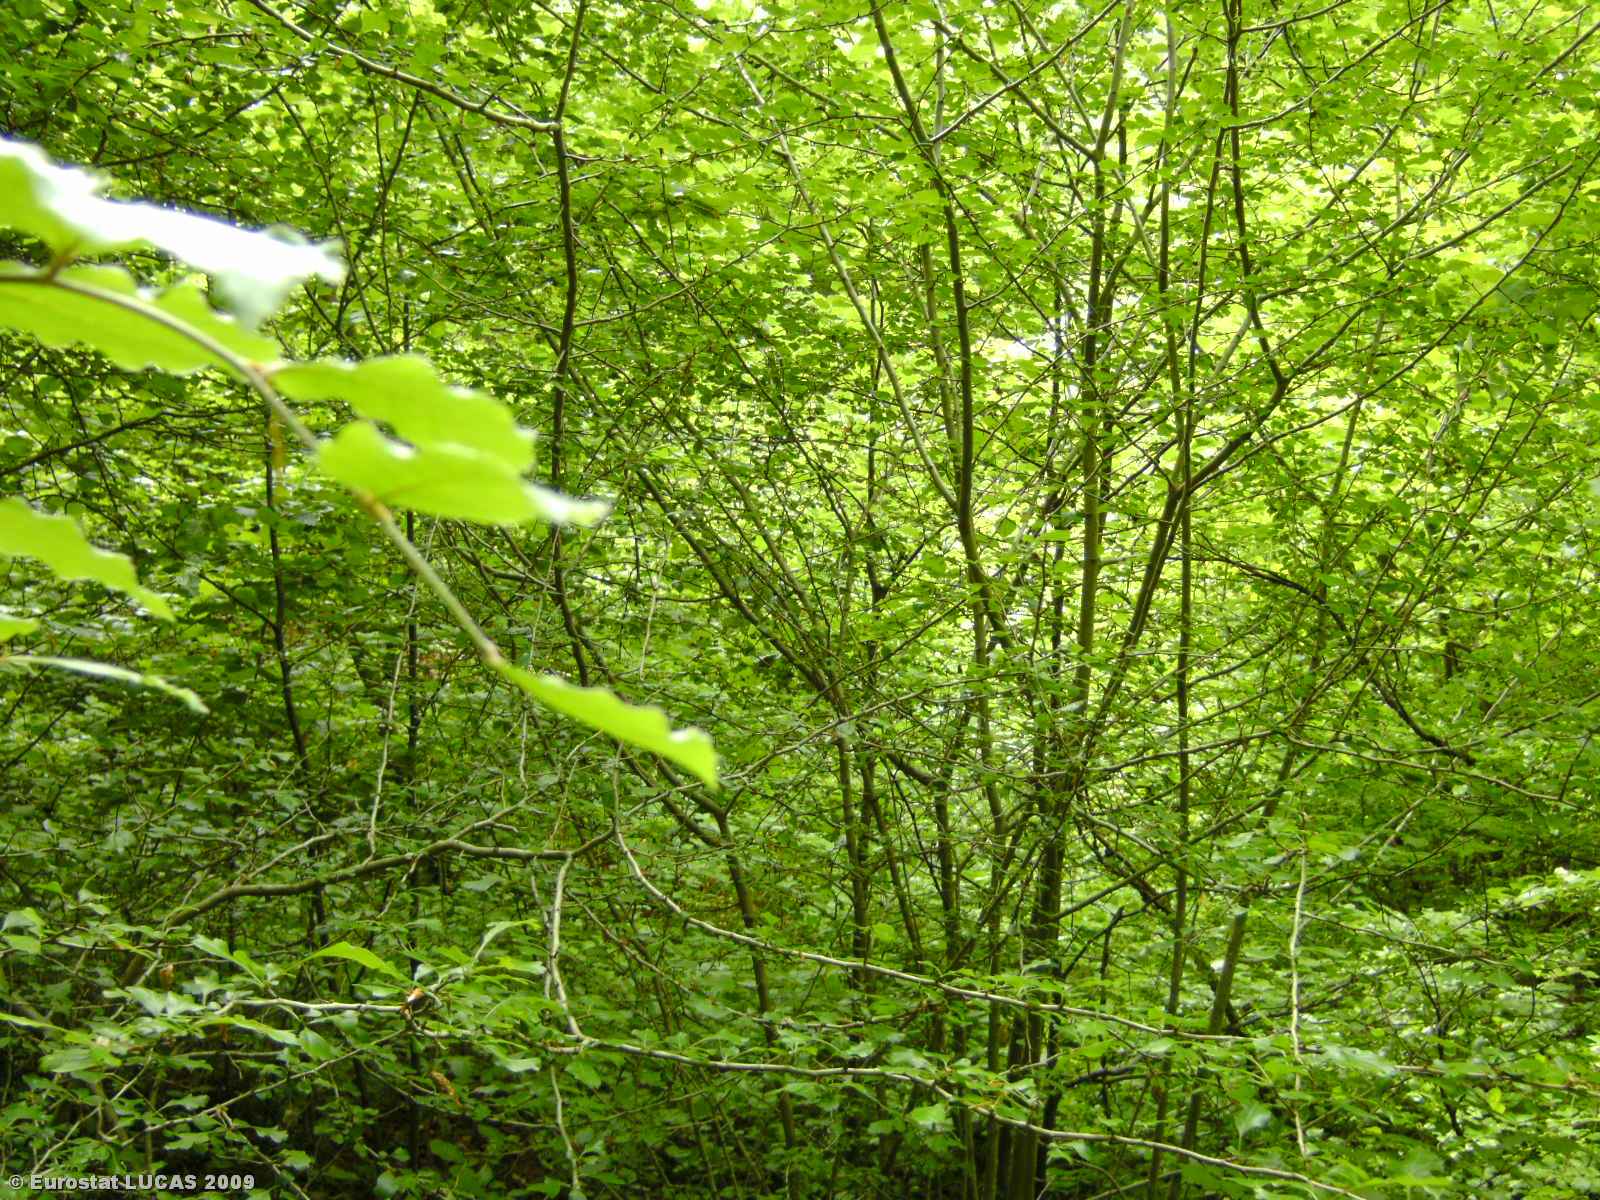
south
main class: Woodland
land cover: Broadleaved woodland
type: beech forest
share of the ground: 50 - 75 %
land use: Forestry
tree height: > 5 m
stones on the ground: < 10 %
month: May
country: LU
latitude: 49.8302
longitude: 6.1207
